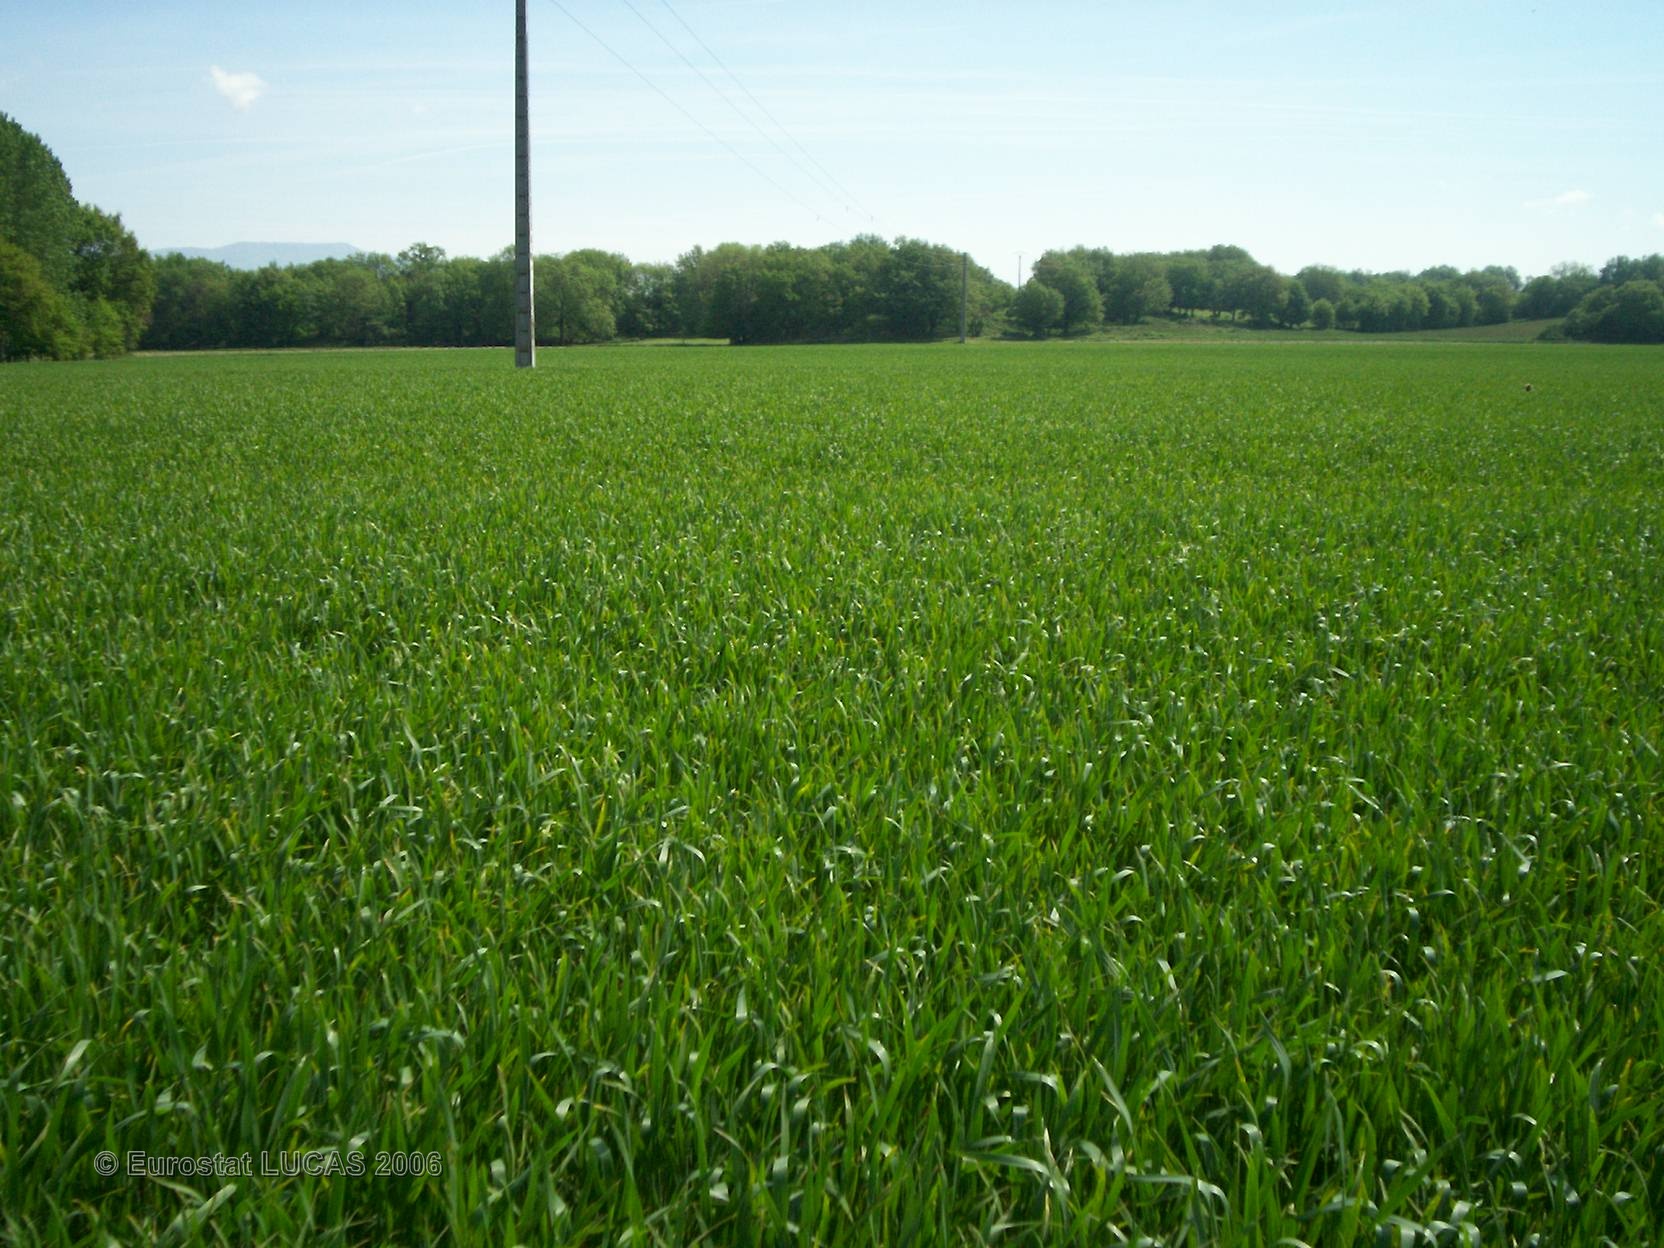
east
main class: Cropland
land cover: Common wheat
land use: Agriculture (excluding fallow land and kitchen gardens)
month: May
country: FR
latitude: 45.6938
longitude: 5.4197
